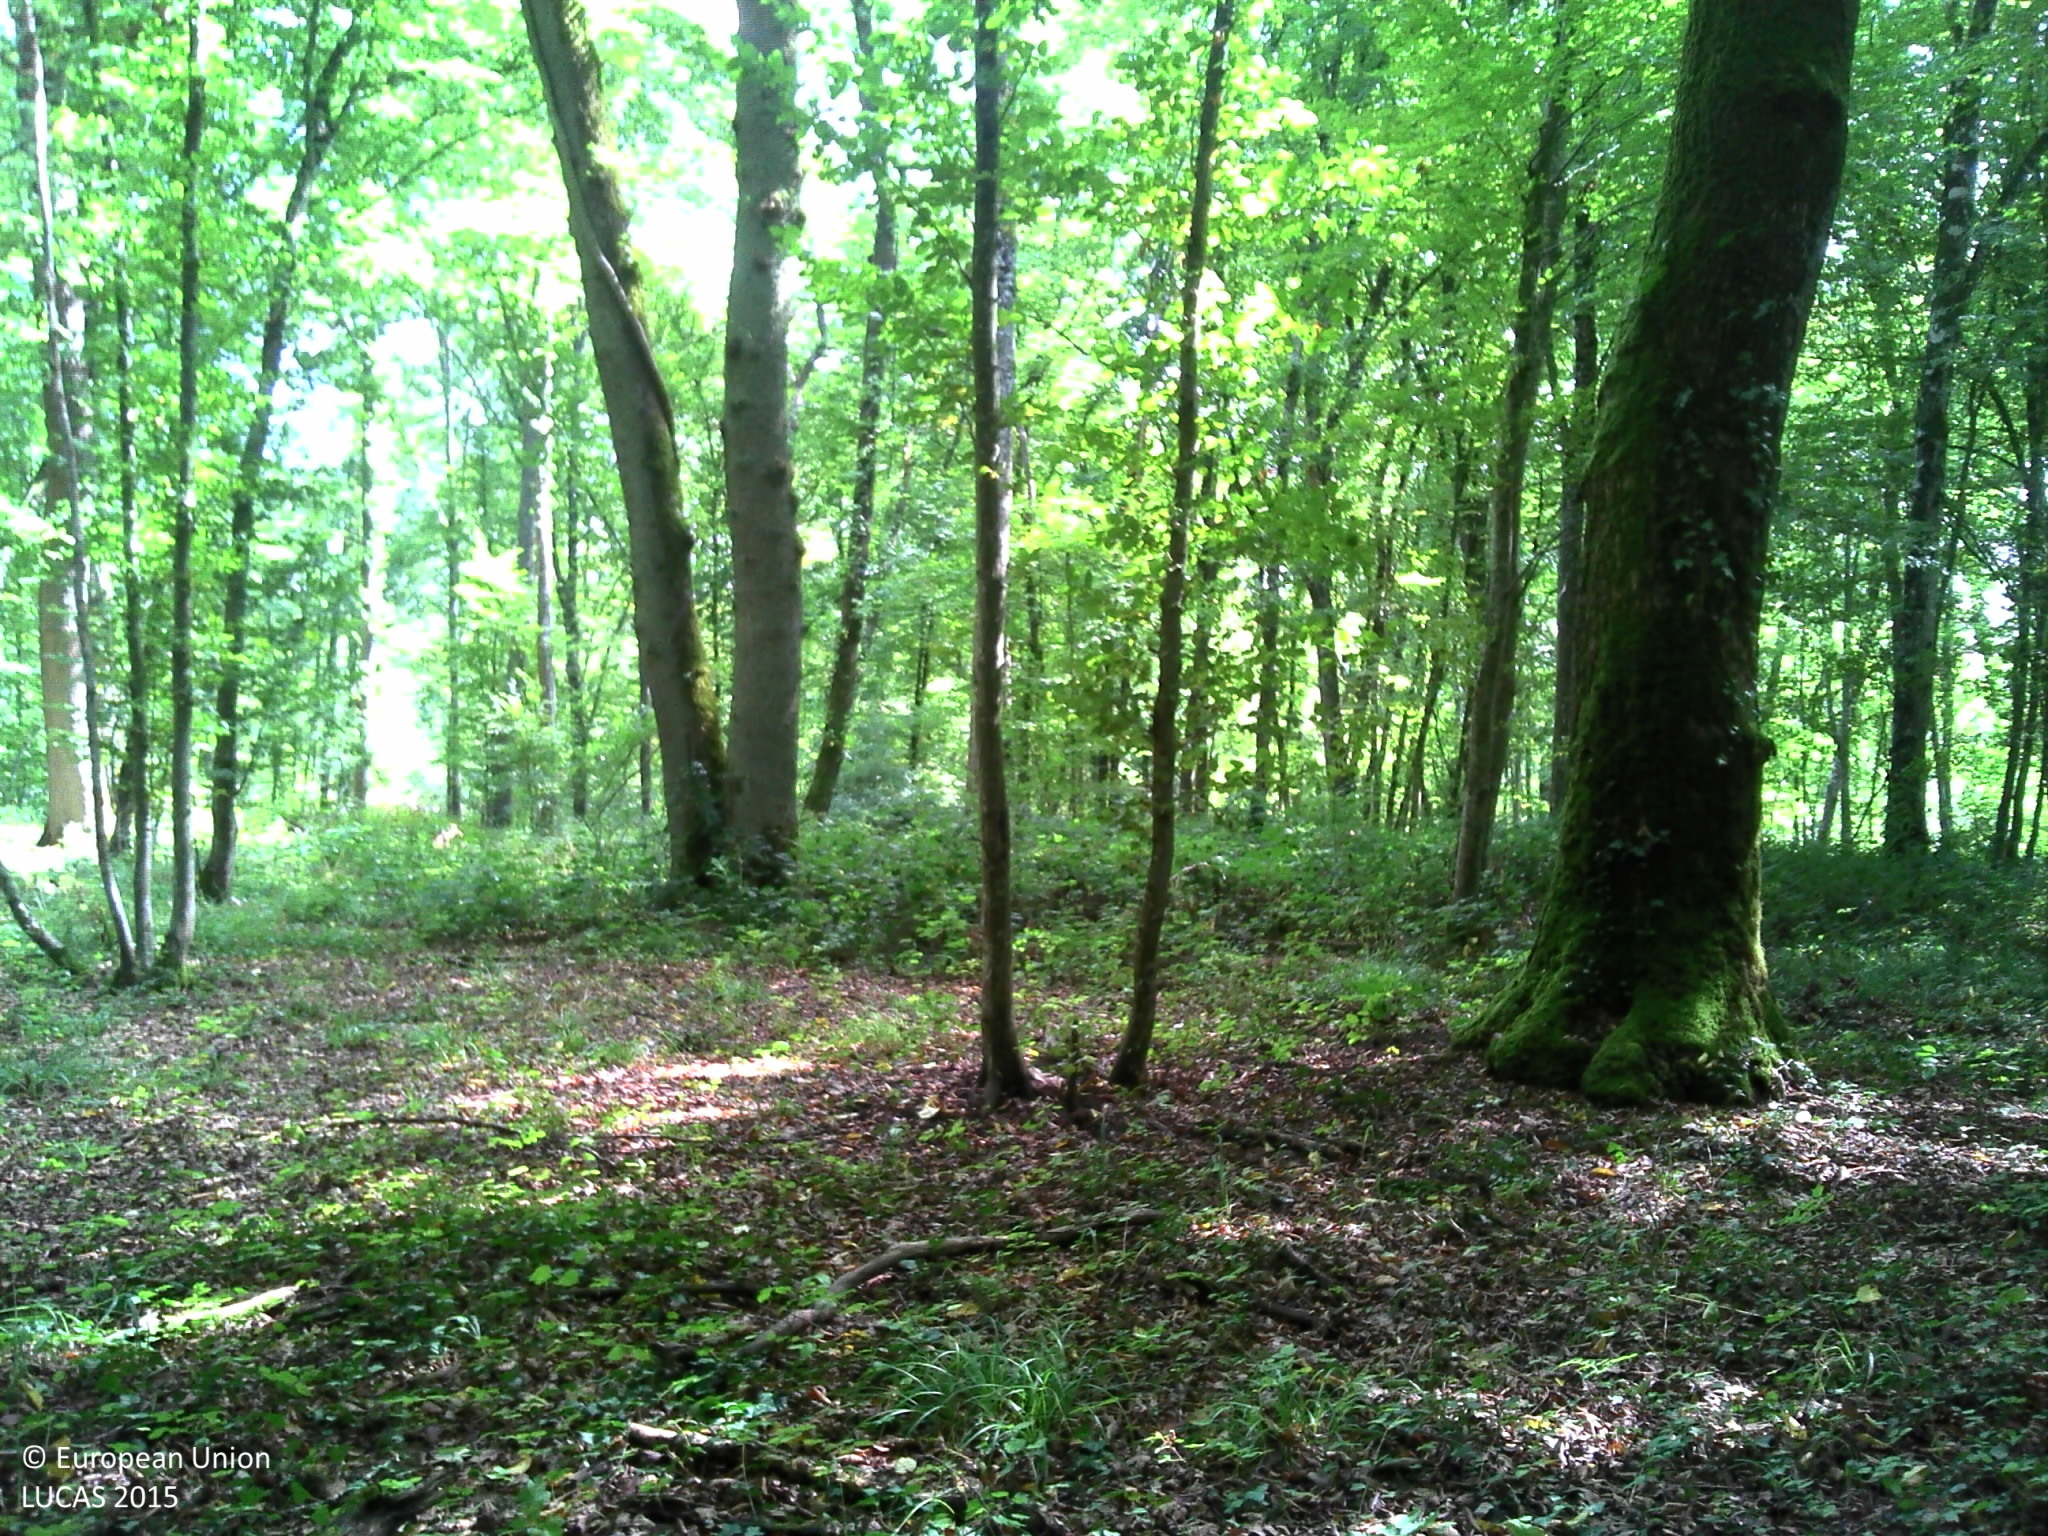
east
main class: Woodland
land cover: Broadleaved woodland
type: mesophytic deciduous forest
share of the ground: > 75 %
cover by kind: broadleaved forest trees 85 %, herbaceous plants 10 %, consolidated bare surface 5 %
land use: Forestry
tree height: > 5 m
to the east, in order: Broadleaved woodland; Tracks; Broadleaved woodland
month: September
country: FR
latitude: 48.7819
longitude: 6.0122
